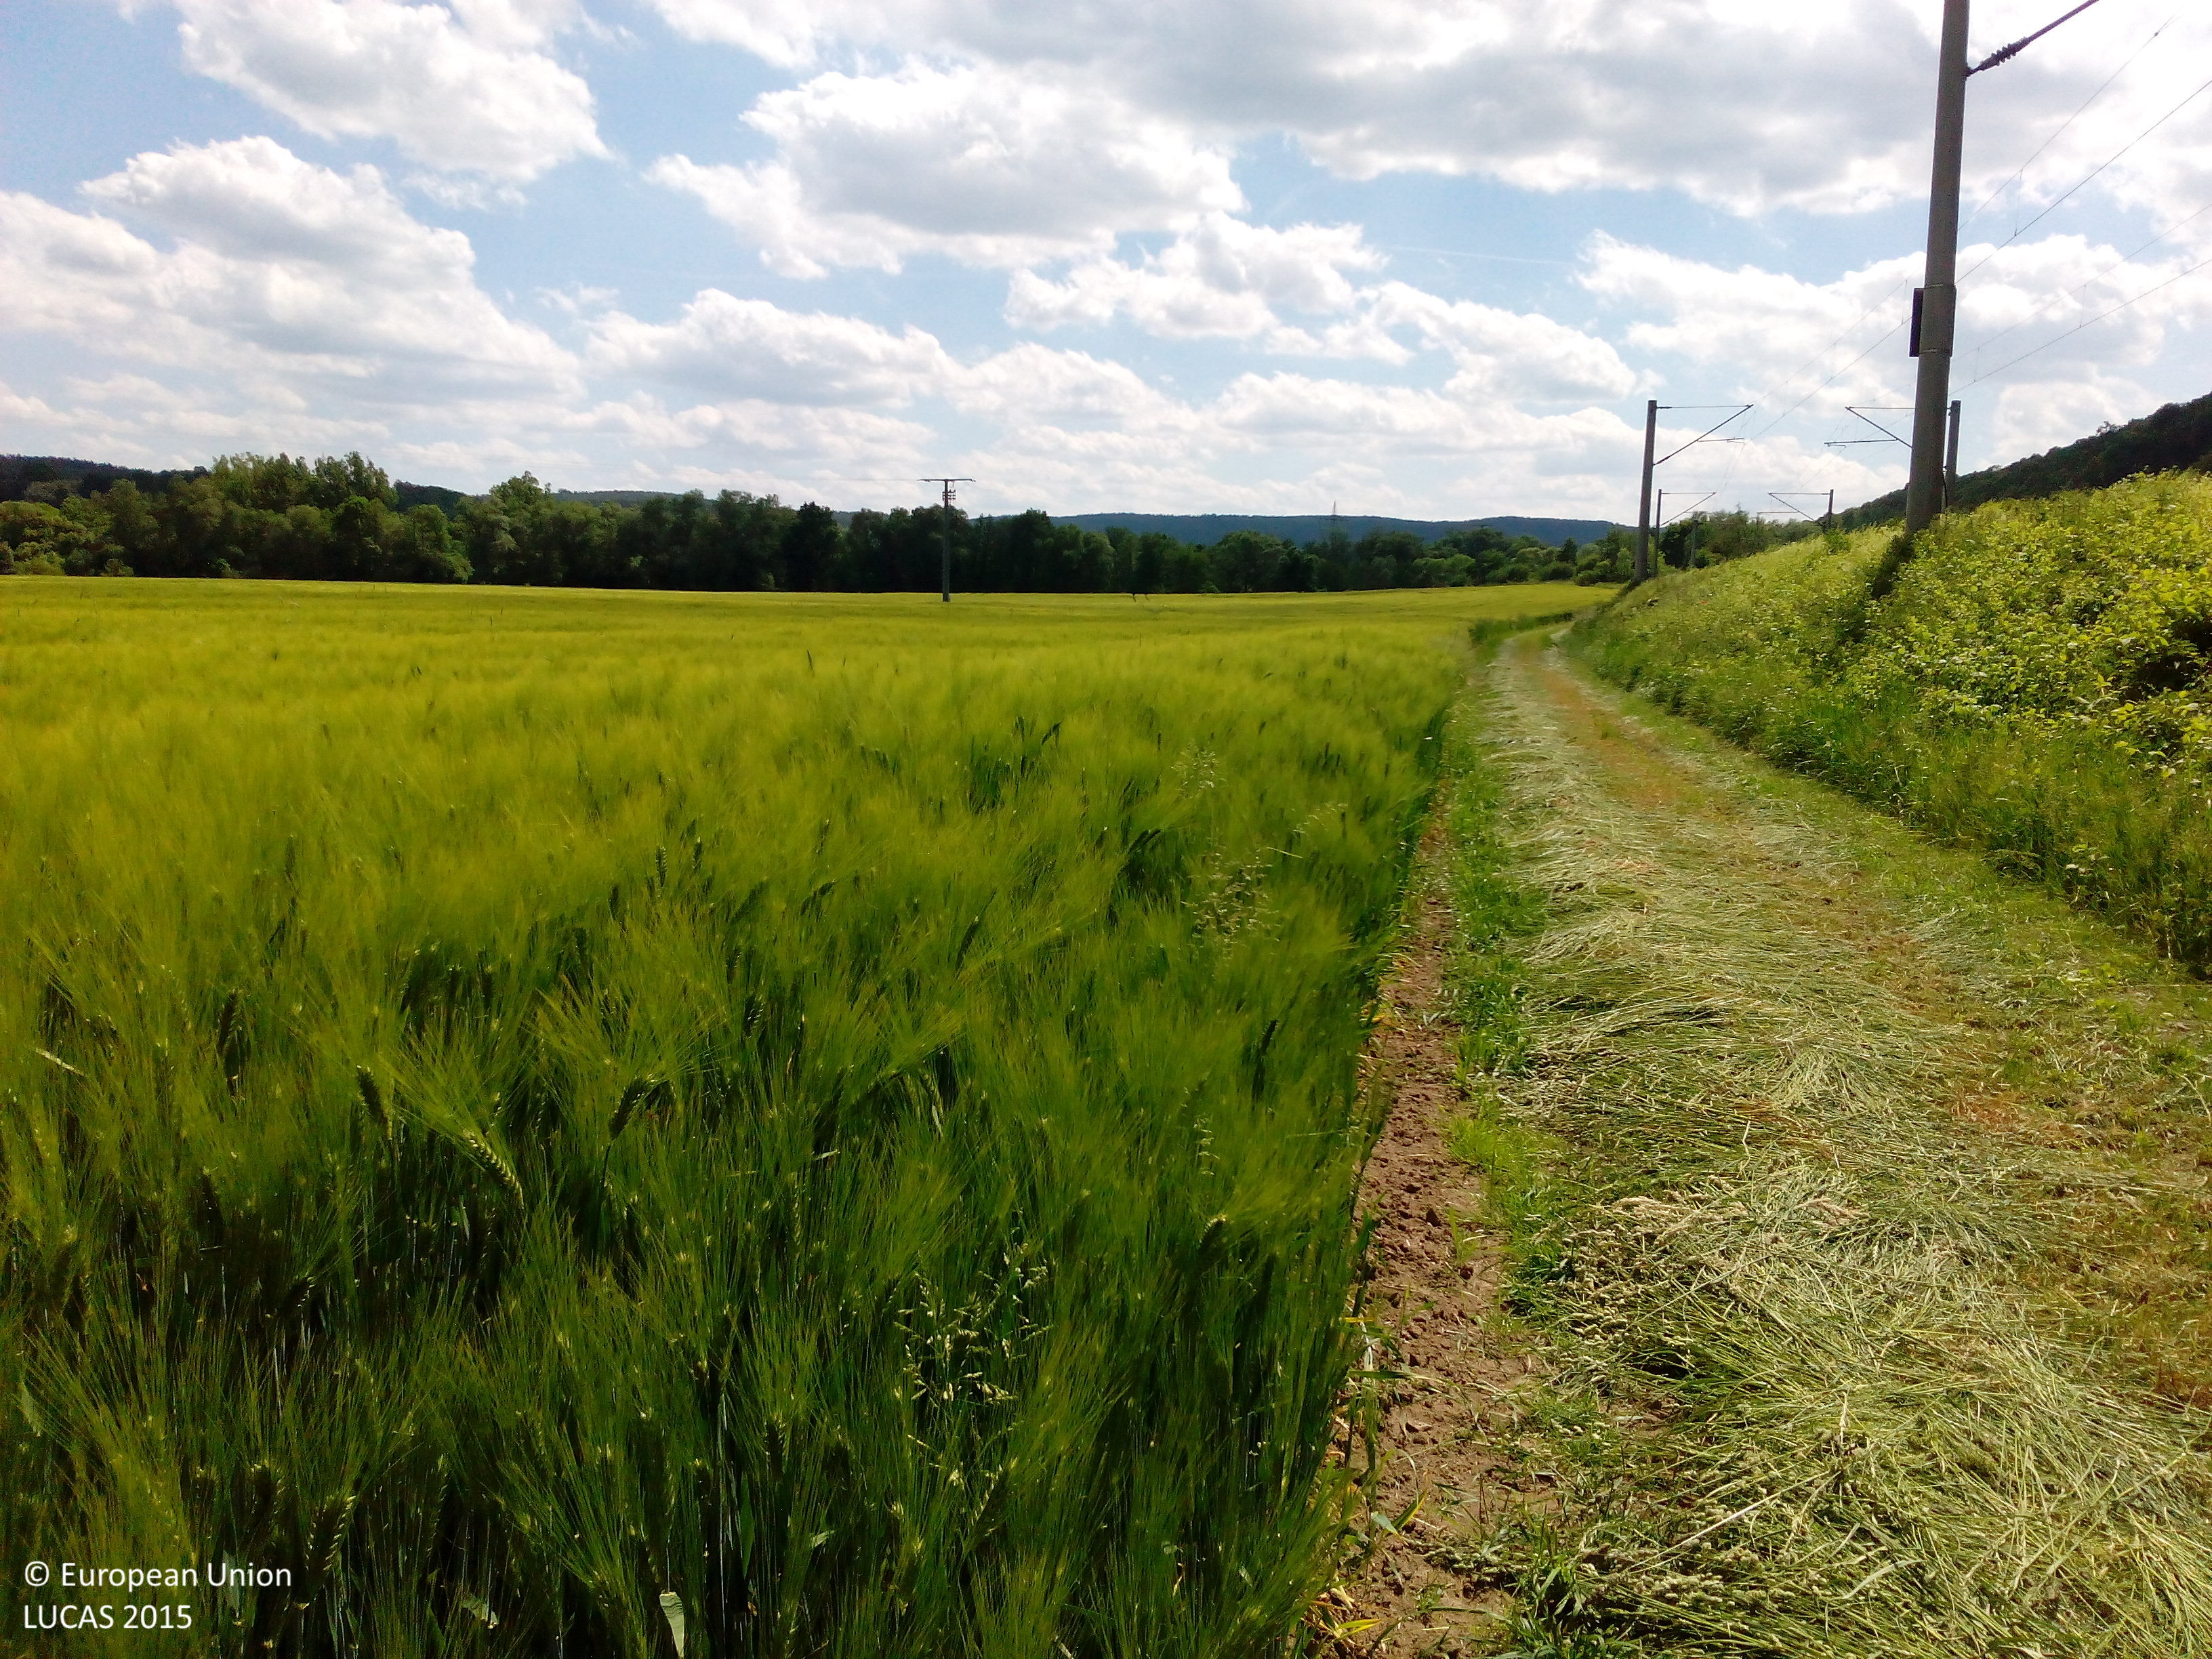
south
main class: Cropland
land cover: Barley
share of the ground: > 75 %
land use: Agriculture (excluding fallow land and kitchen gardens)
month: June
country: DE
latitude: 50.7676
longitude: 11.5168
